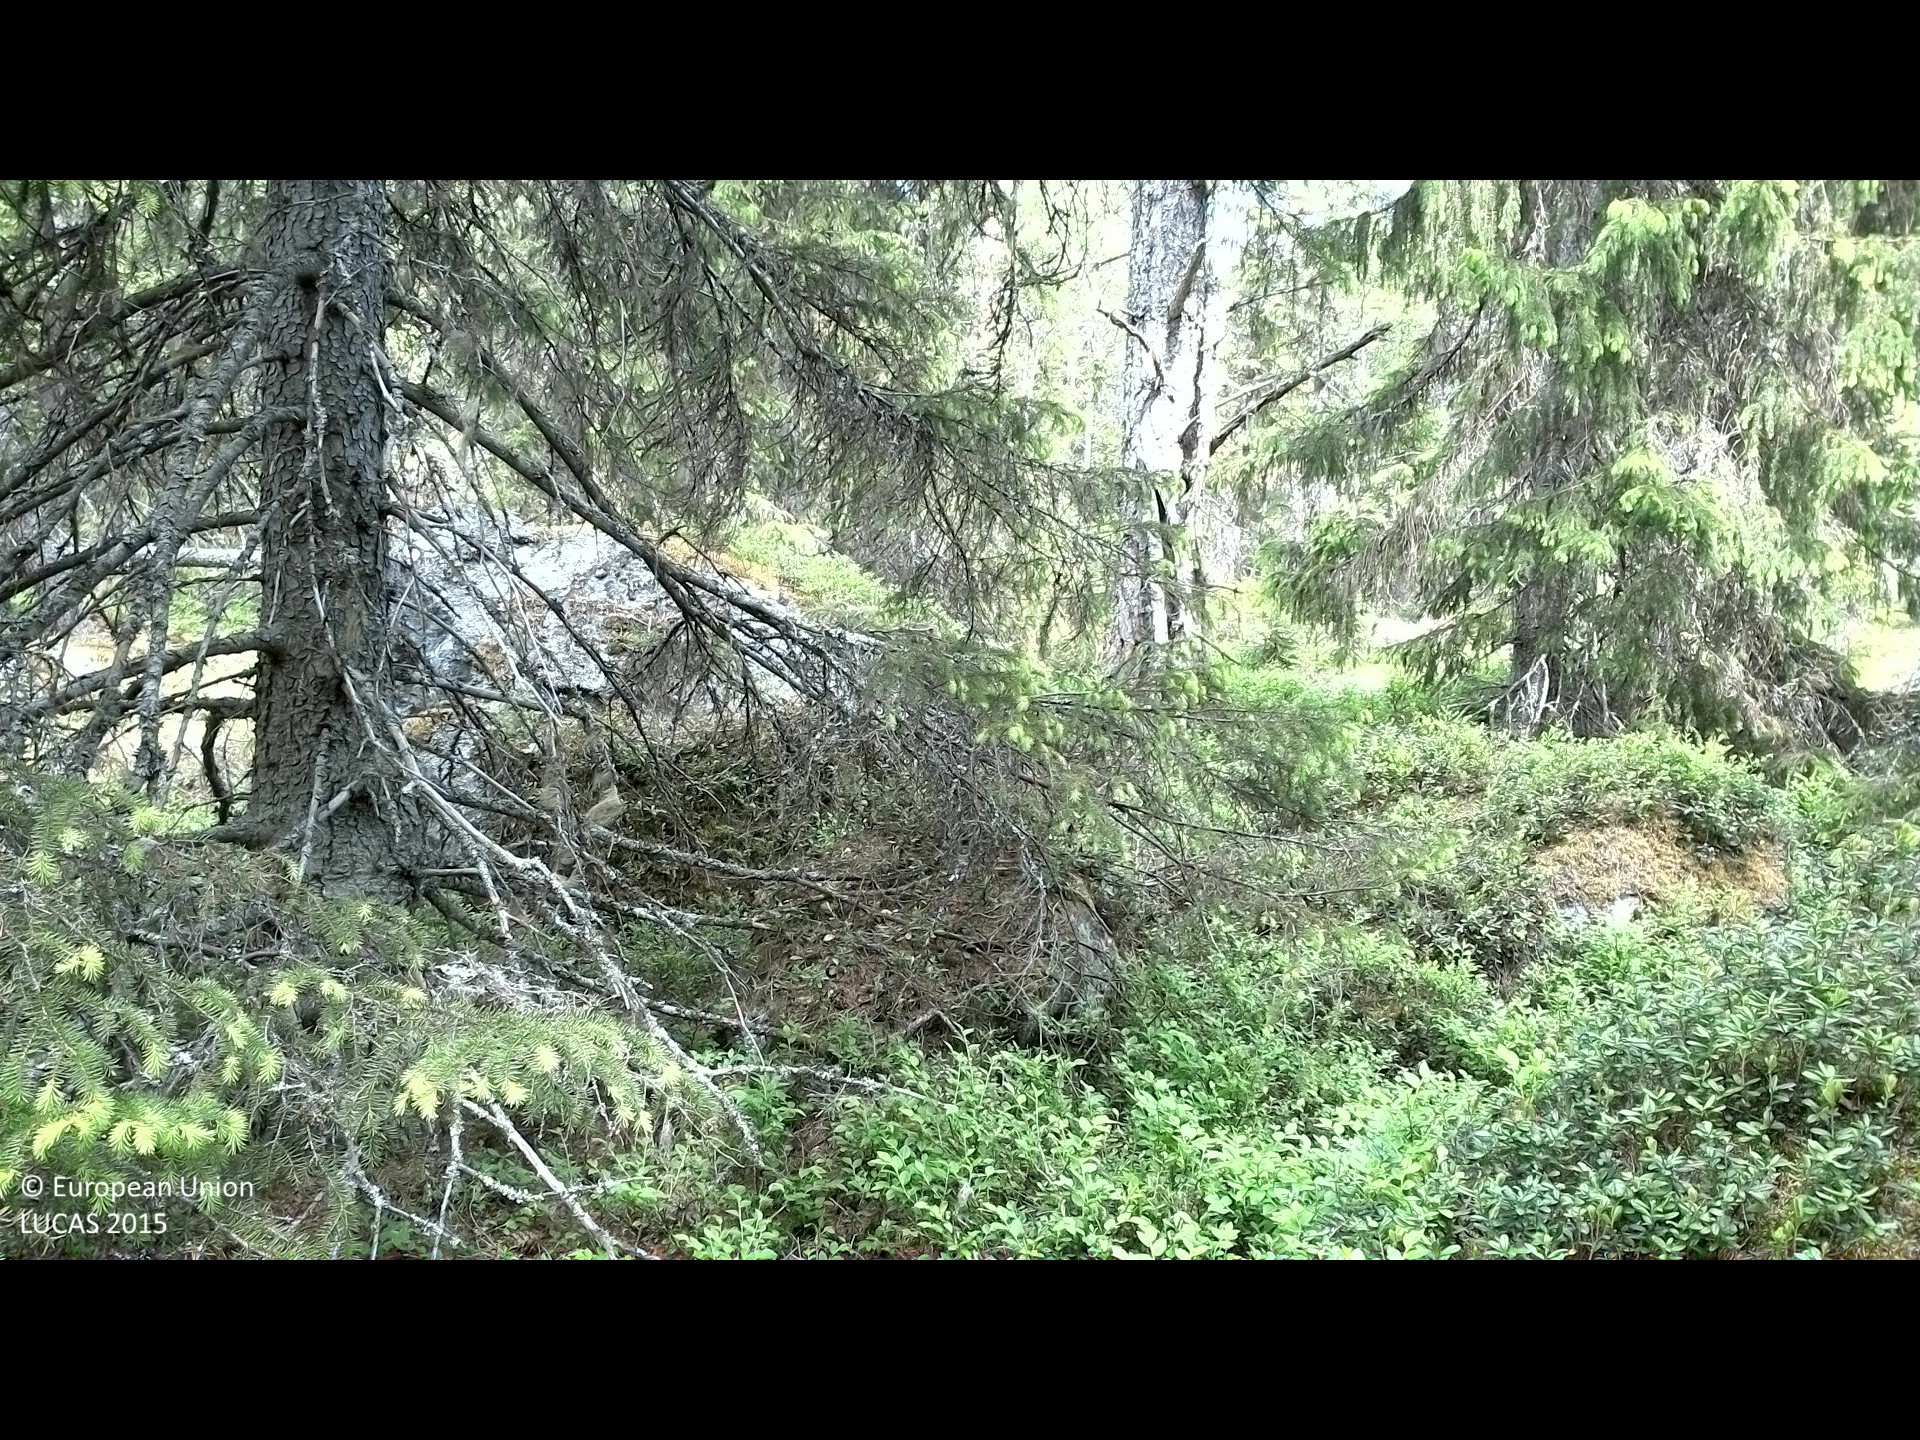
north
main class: Woodland
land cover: Spruce dominated coniferous woodland
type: boreal forest
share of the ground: 50 - 75 %
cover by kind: coniferous forest trees 60 %, lichens and mosses 20 %, shrubs 15 %, herbaceous plants 5 %
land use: Amenities, museums, leisure
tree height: > 5 m
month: June
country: SE
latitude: 62.2201
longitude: 17.6174
